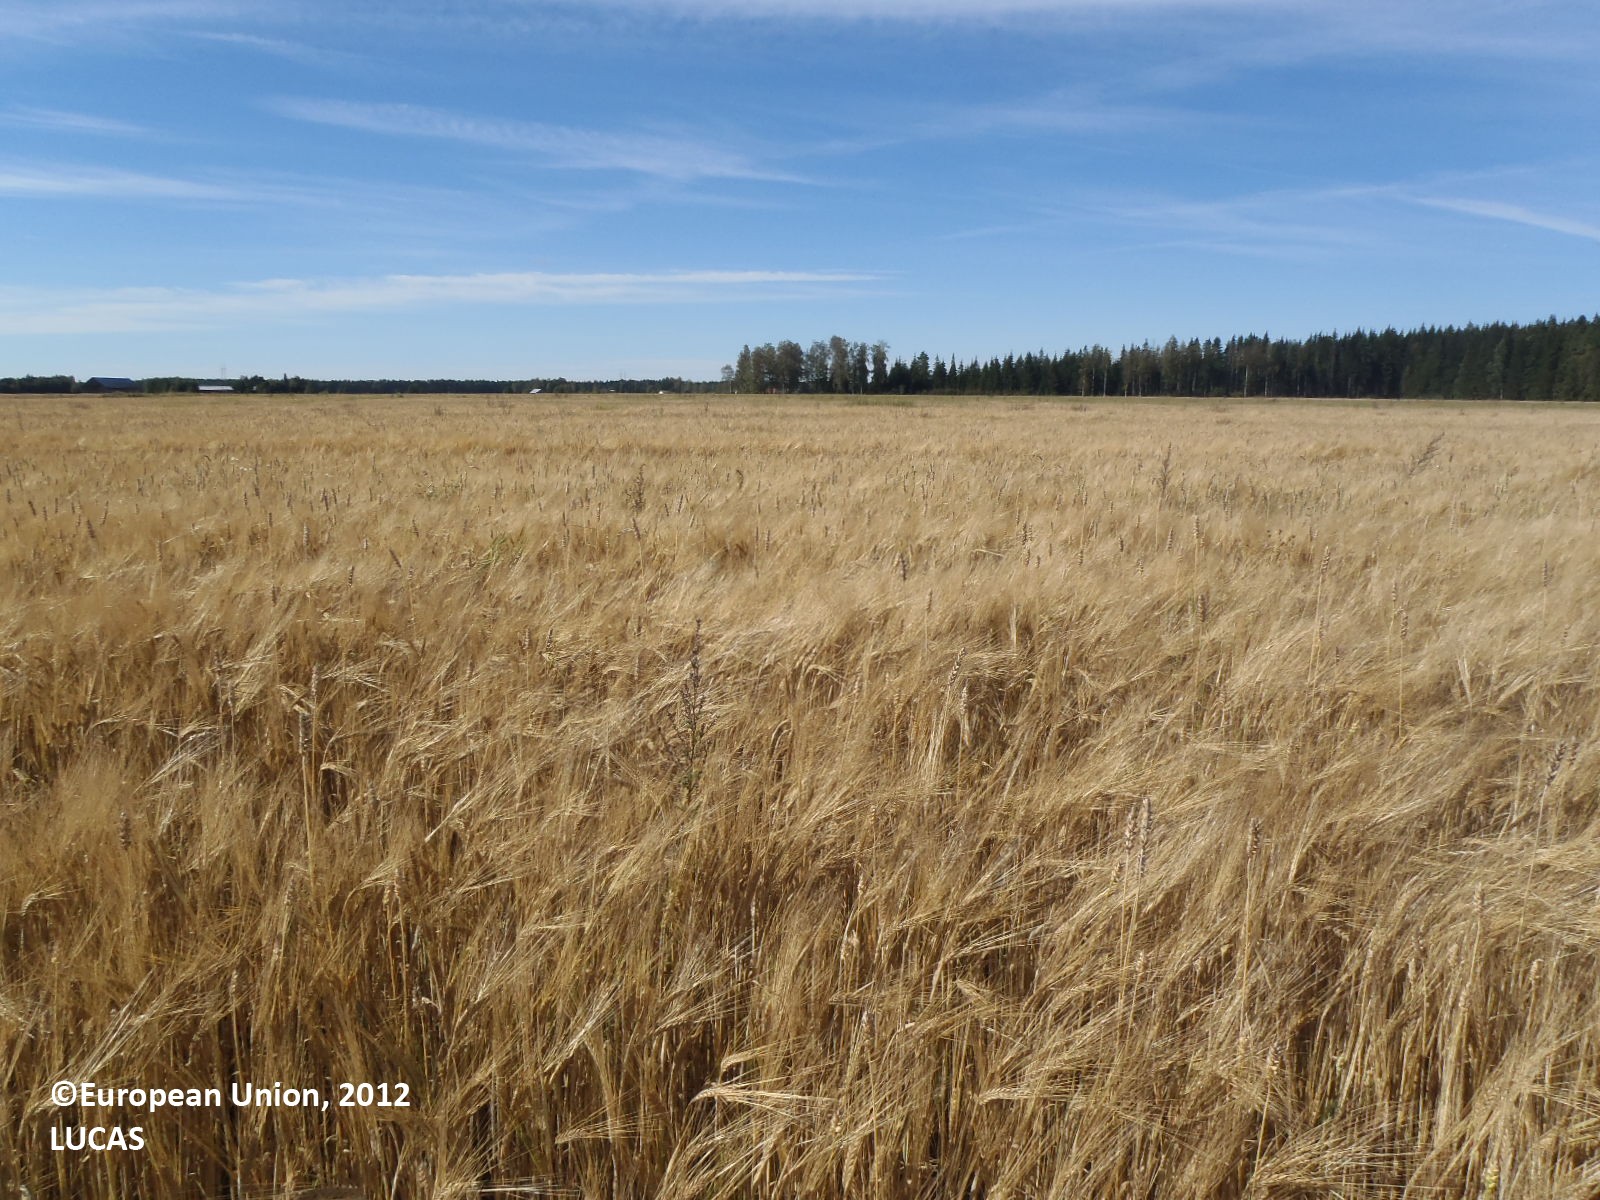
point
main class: Cropland
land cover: Common wheat
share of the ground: 25 - 50 %
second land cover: Barley
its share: 50 - 75 %
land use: Agriculture (excluding fallow land and kitchen gardens)
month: September
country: FI
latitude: 61.0808
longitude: 22.3173
